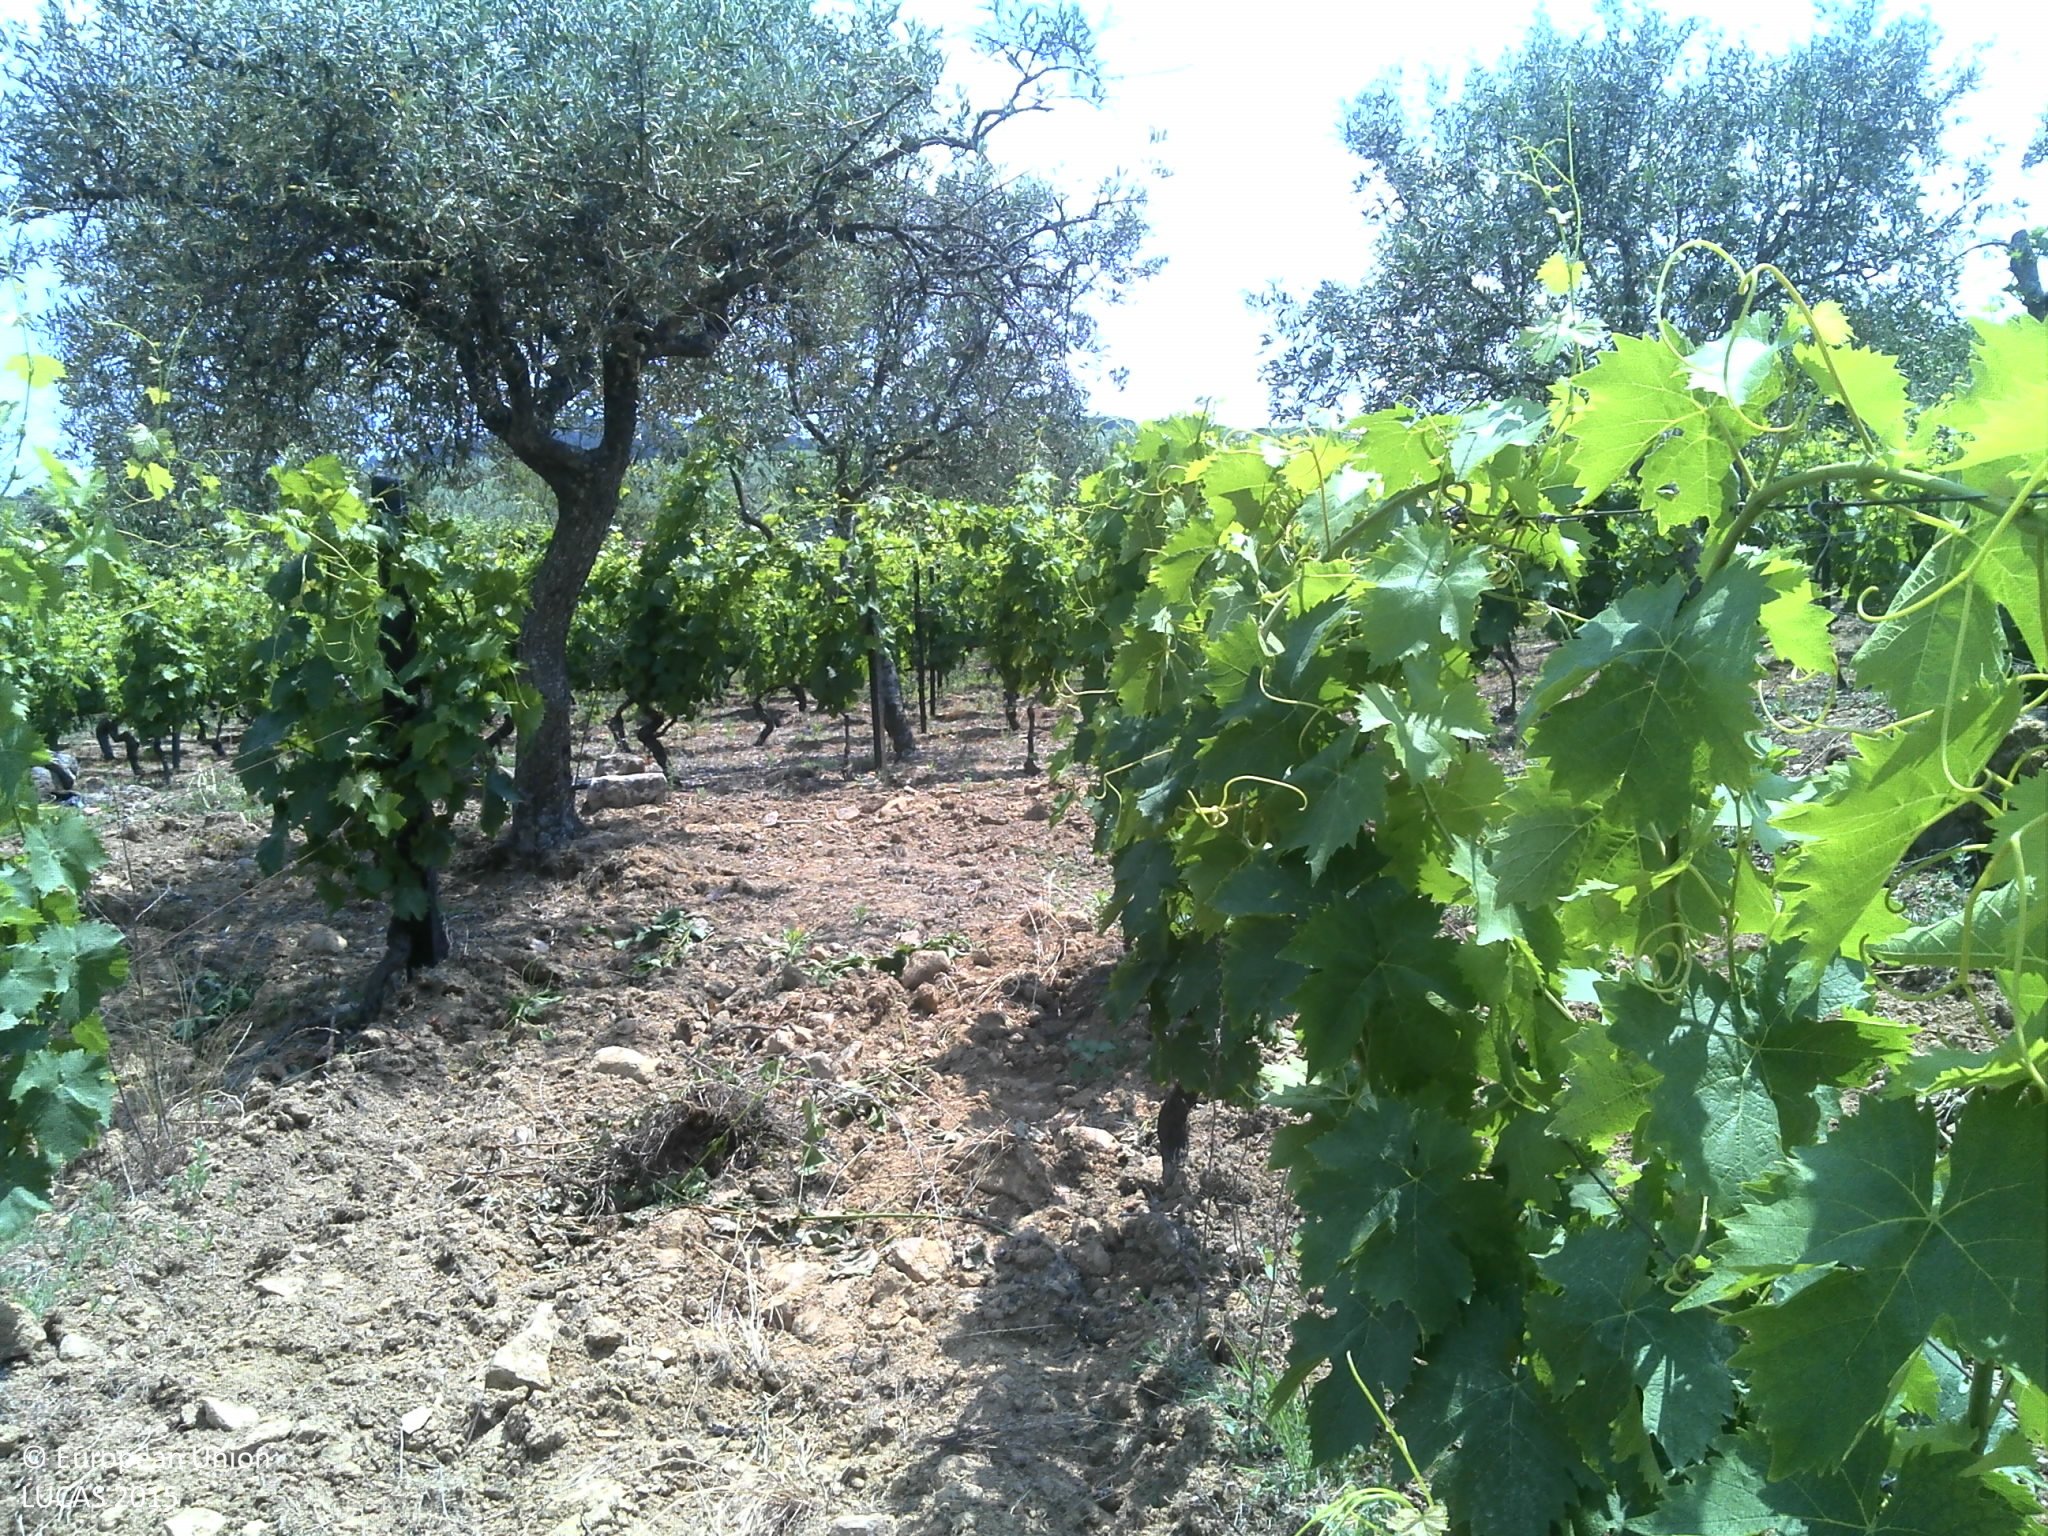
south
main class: Cropland
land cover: Vineyards
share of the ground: 10 - 25 %
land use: Agriculture (excluding fallow land and kitchen gardens)
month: June
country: PT
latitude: 41.2697
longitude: -7.4676
